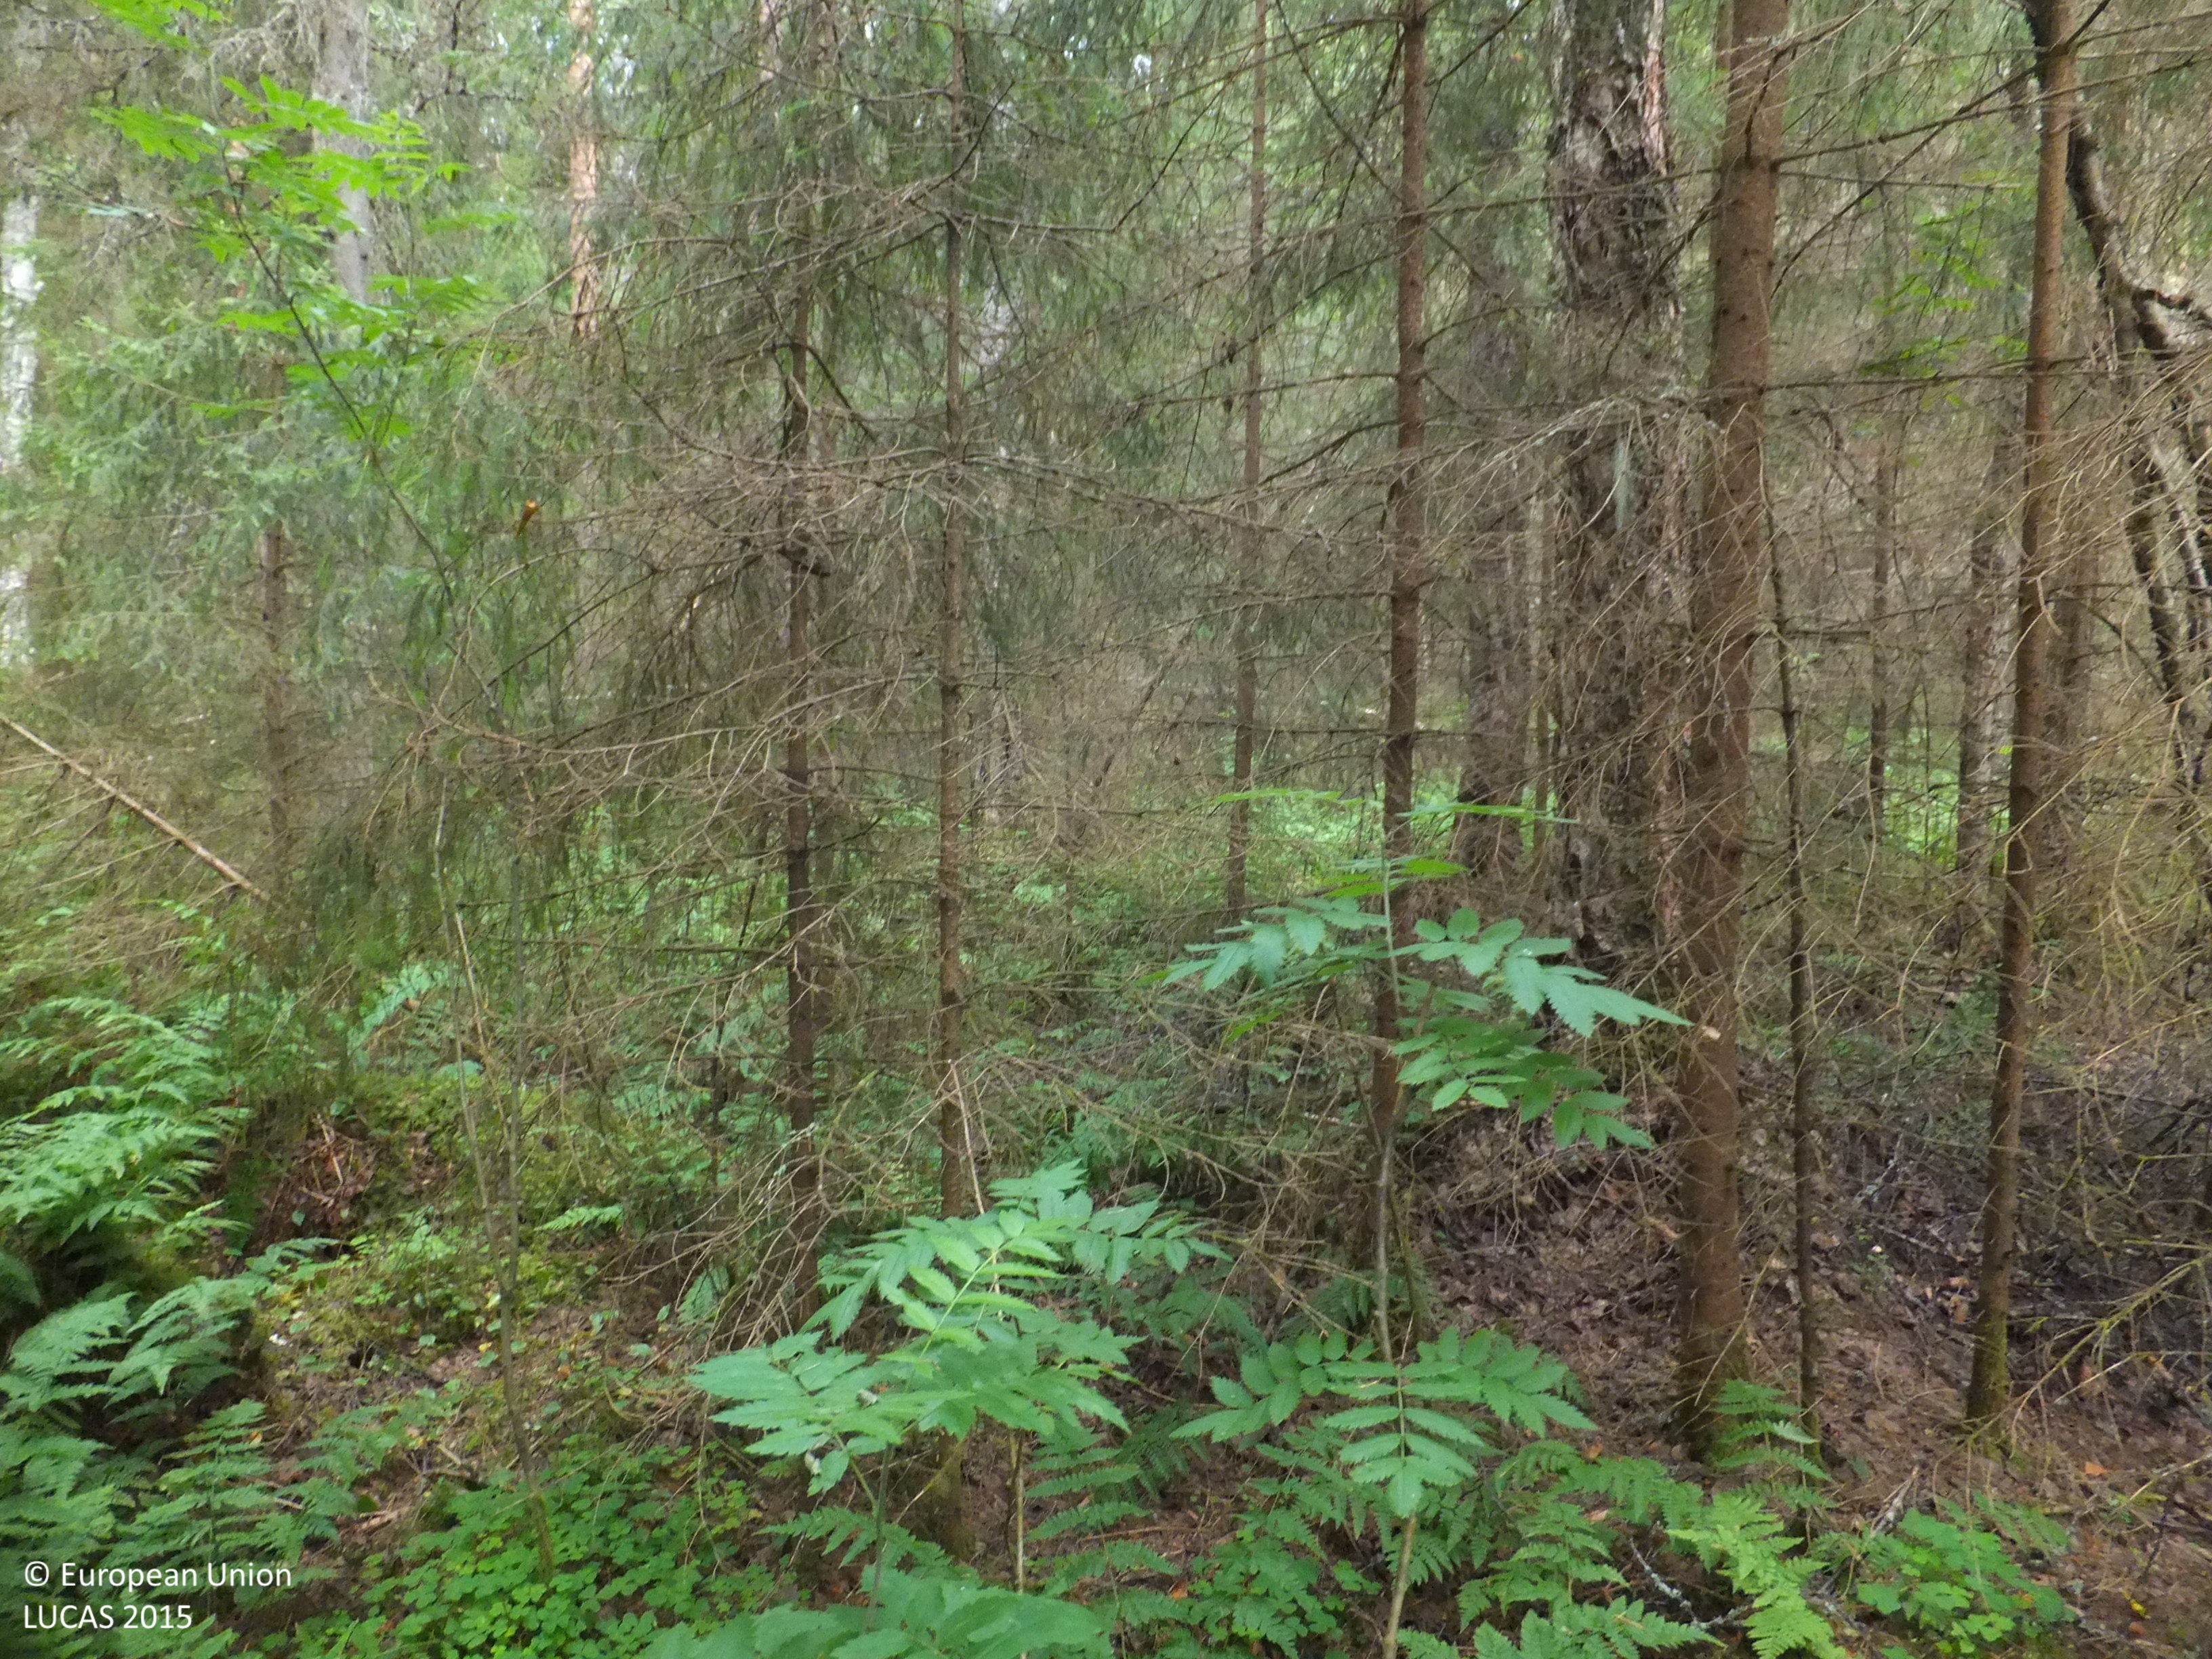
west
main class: Woodland
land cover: Other mixed woodland
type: boreal forest
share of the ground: > 75 %
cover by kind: coniferous forest trees 60 %, broadleaved forest trees 30 %, herbaceous plants 5 %, lichens and mosses 5 %
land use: Forestry
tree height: > 5 m
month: July
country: FI
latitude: 63.6530
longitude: 23.2853
